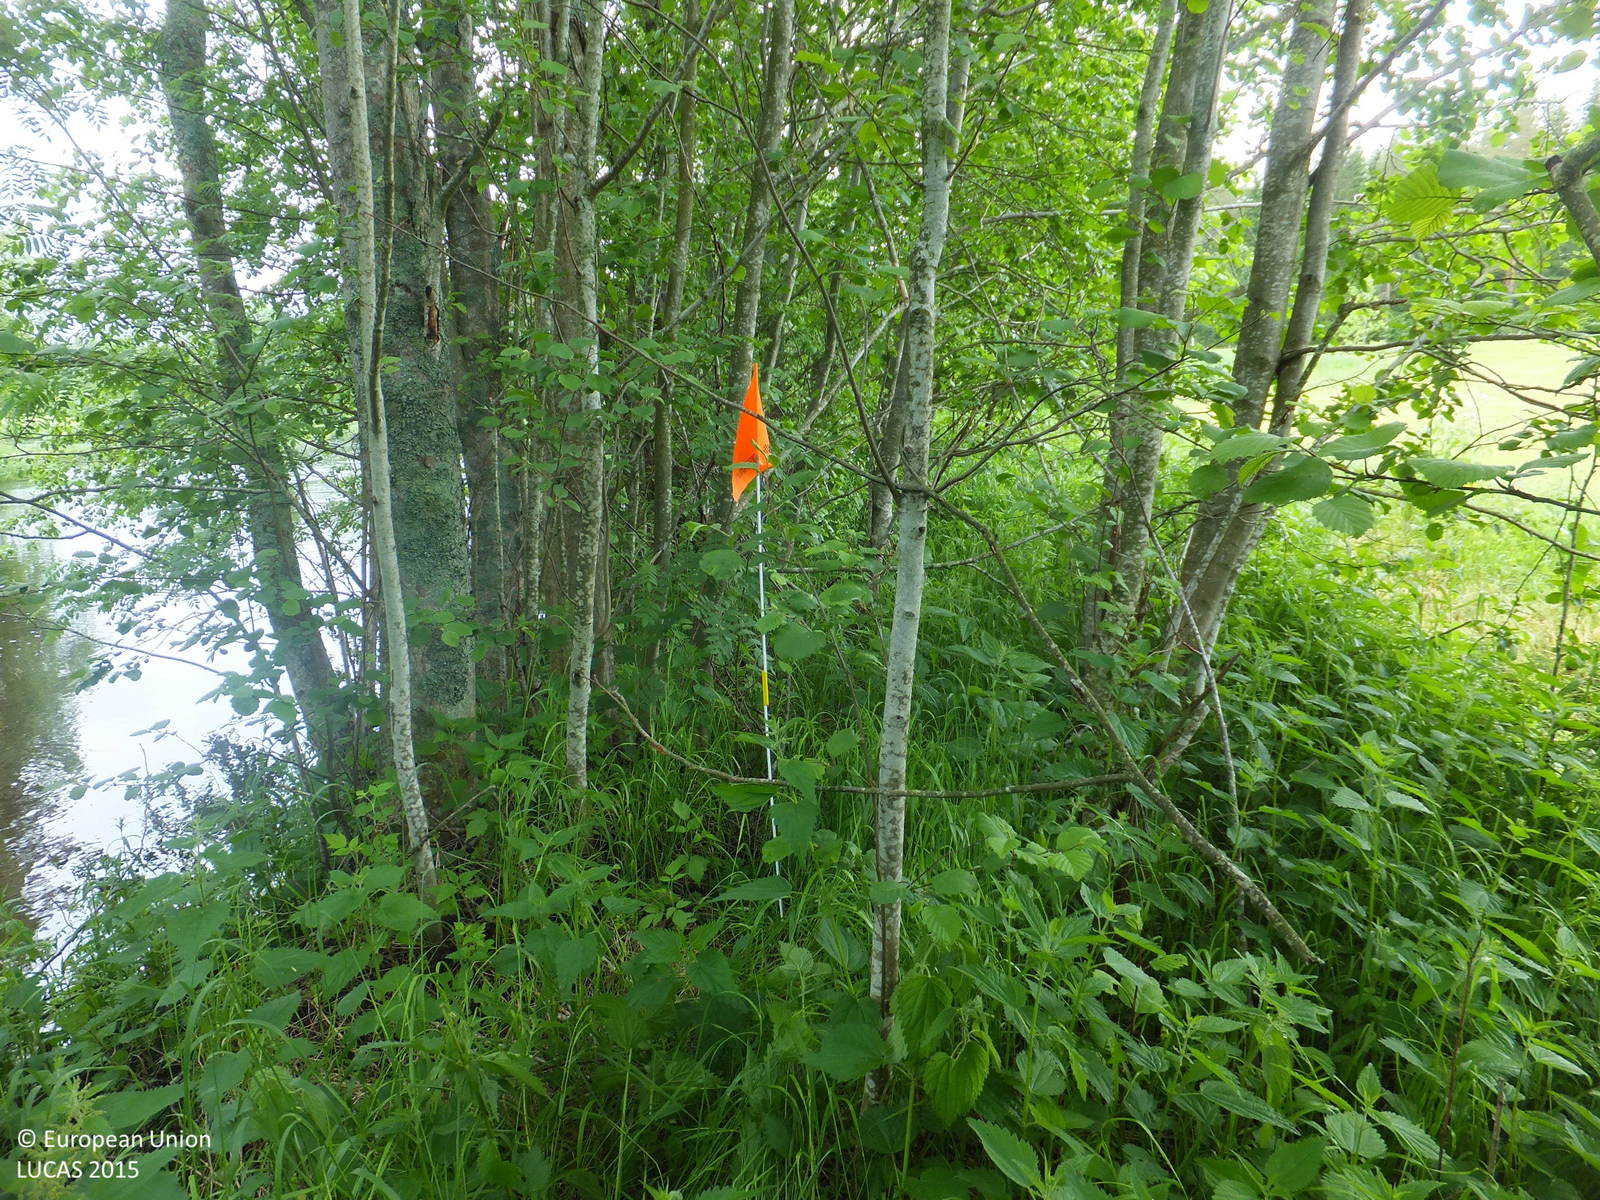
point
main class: Woodland
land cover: Broadleaved woodland
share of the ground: 50 - 75 %
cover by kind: broadleaved forest trees 60 %, herbaceous plants 40 %
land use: Semi-natural and natural areas not in use
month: June
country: FI
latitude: 63.3293
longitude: 24.0309
